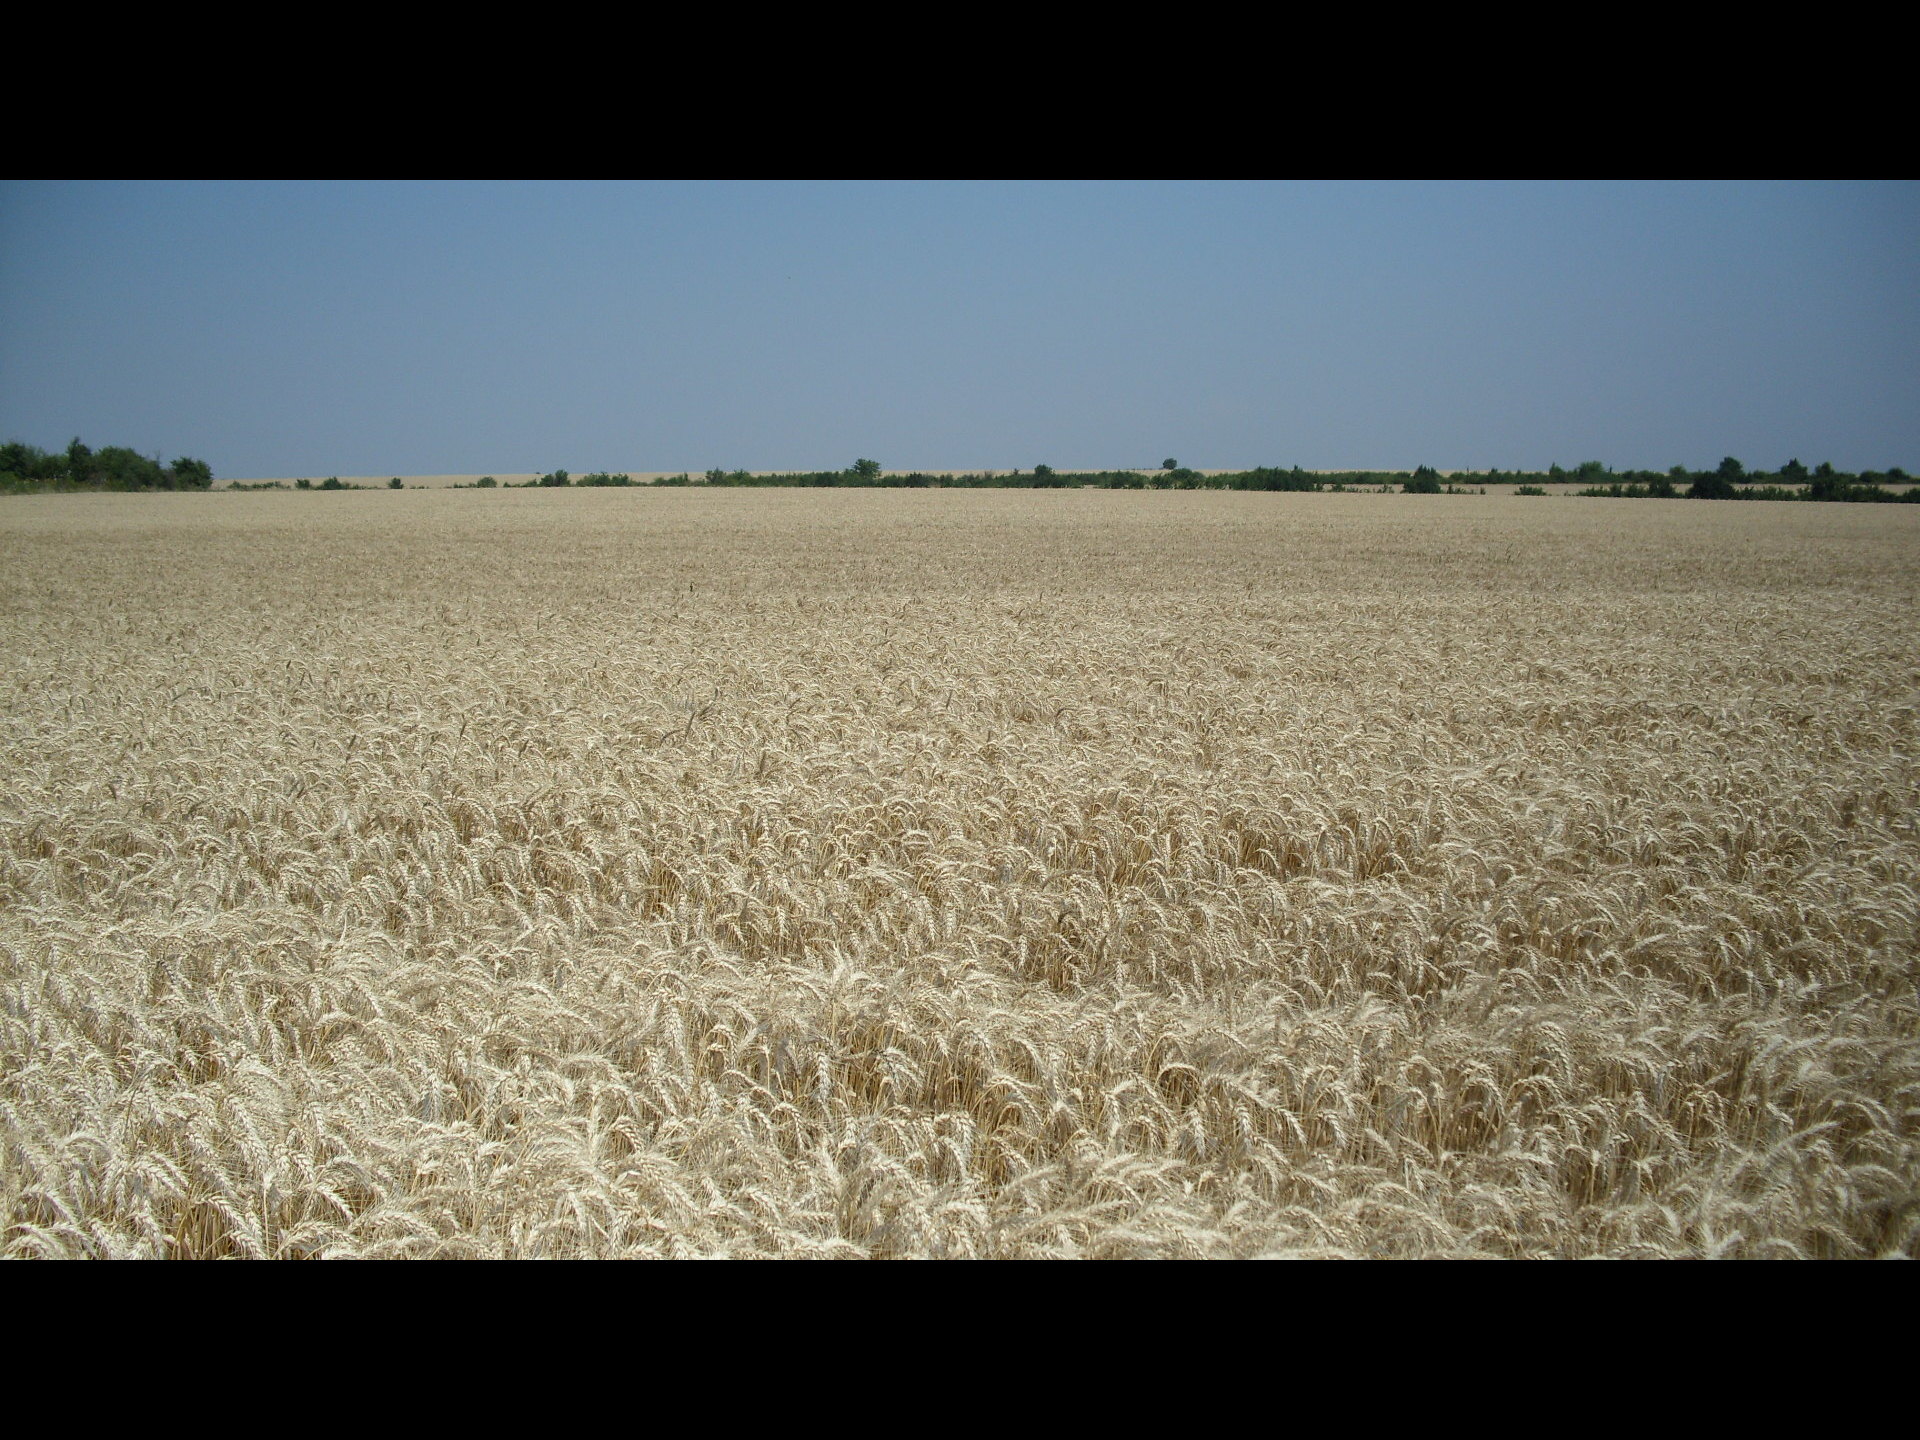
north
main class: Cropland
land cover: Common wheat
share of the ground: > 75 %
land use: Agriculture (excluding fallow land and kitchen gardens)
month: July
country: BG
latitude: 43.7019
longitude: 22.9308
